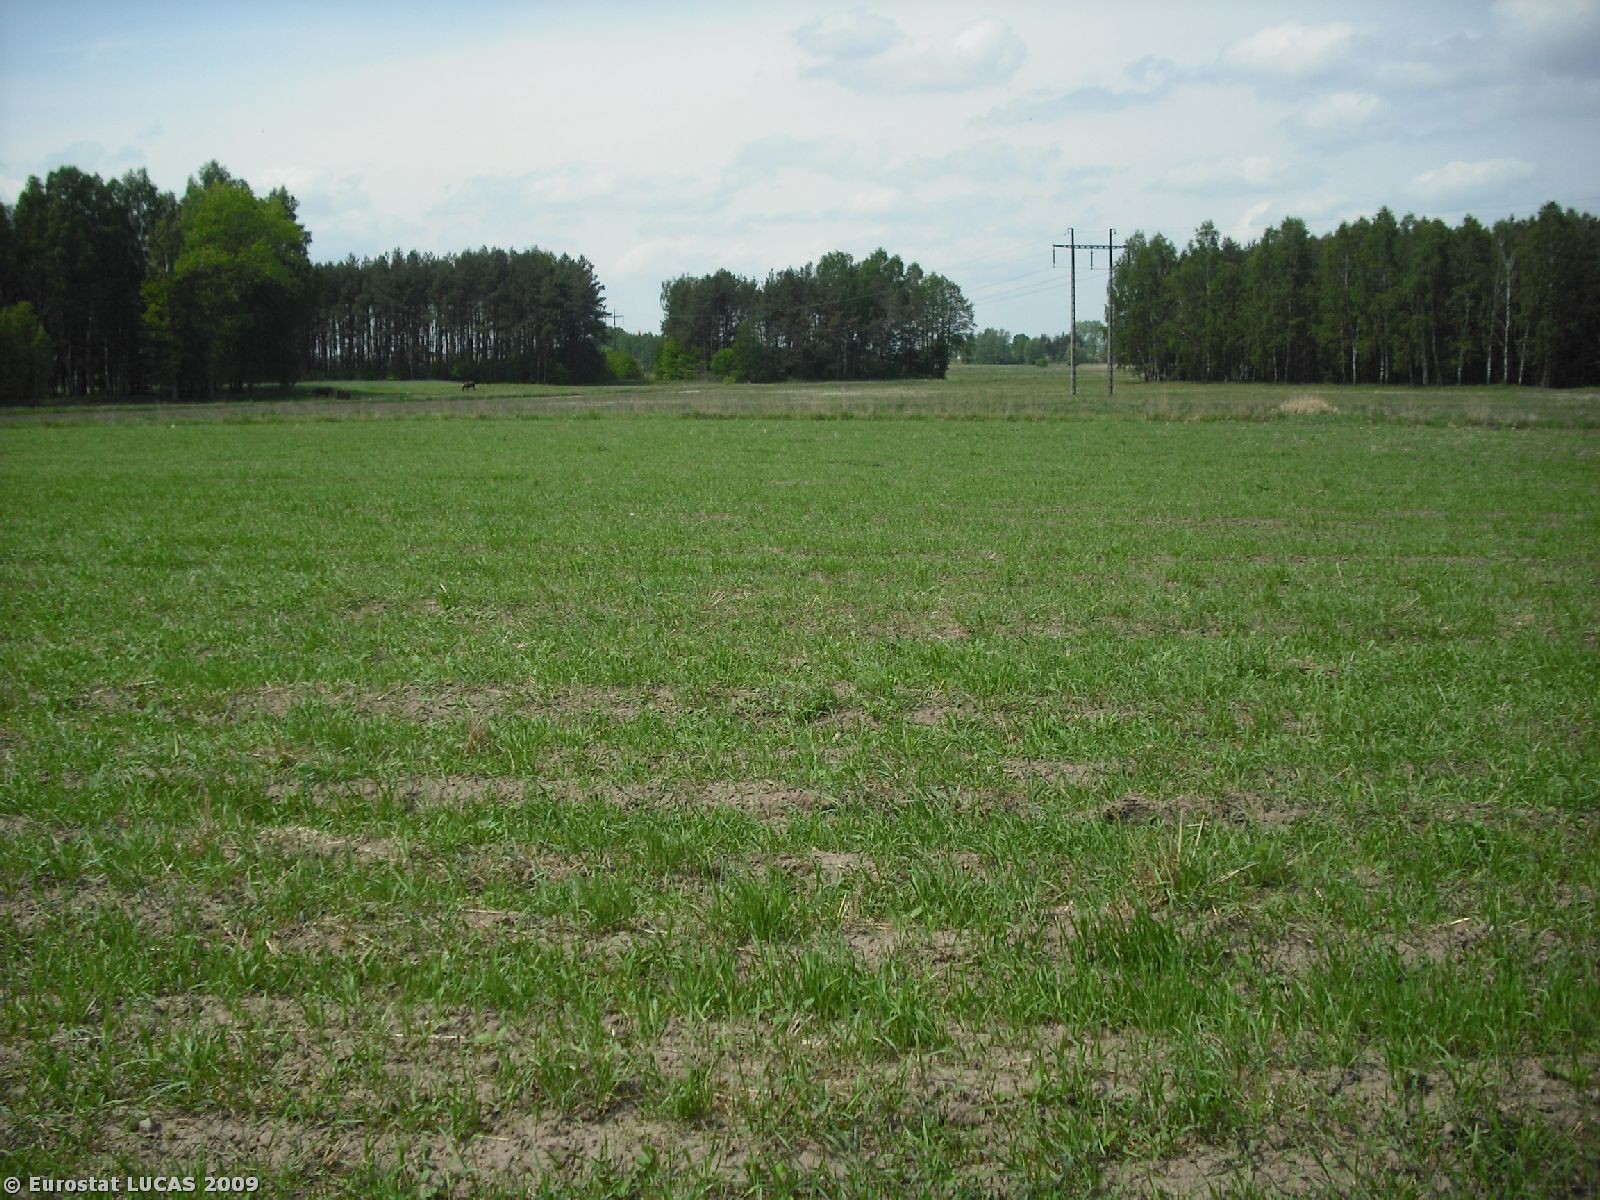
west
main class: Cropland
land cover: Oats
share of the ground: 50 - 75 %
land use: Agriculture (excluding fallow land and kitchen gardens)
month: May
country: PL
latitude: 52.7813
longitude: 23.2294
